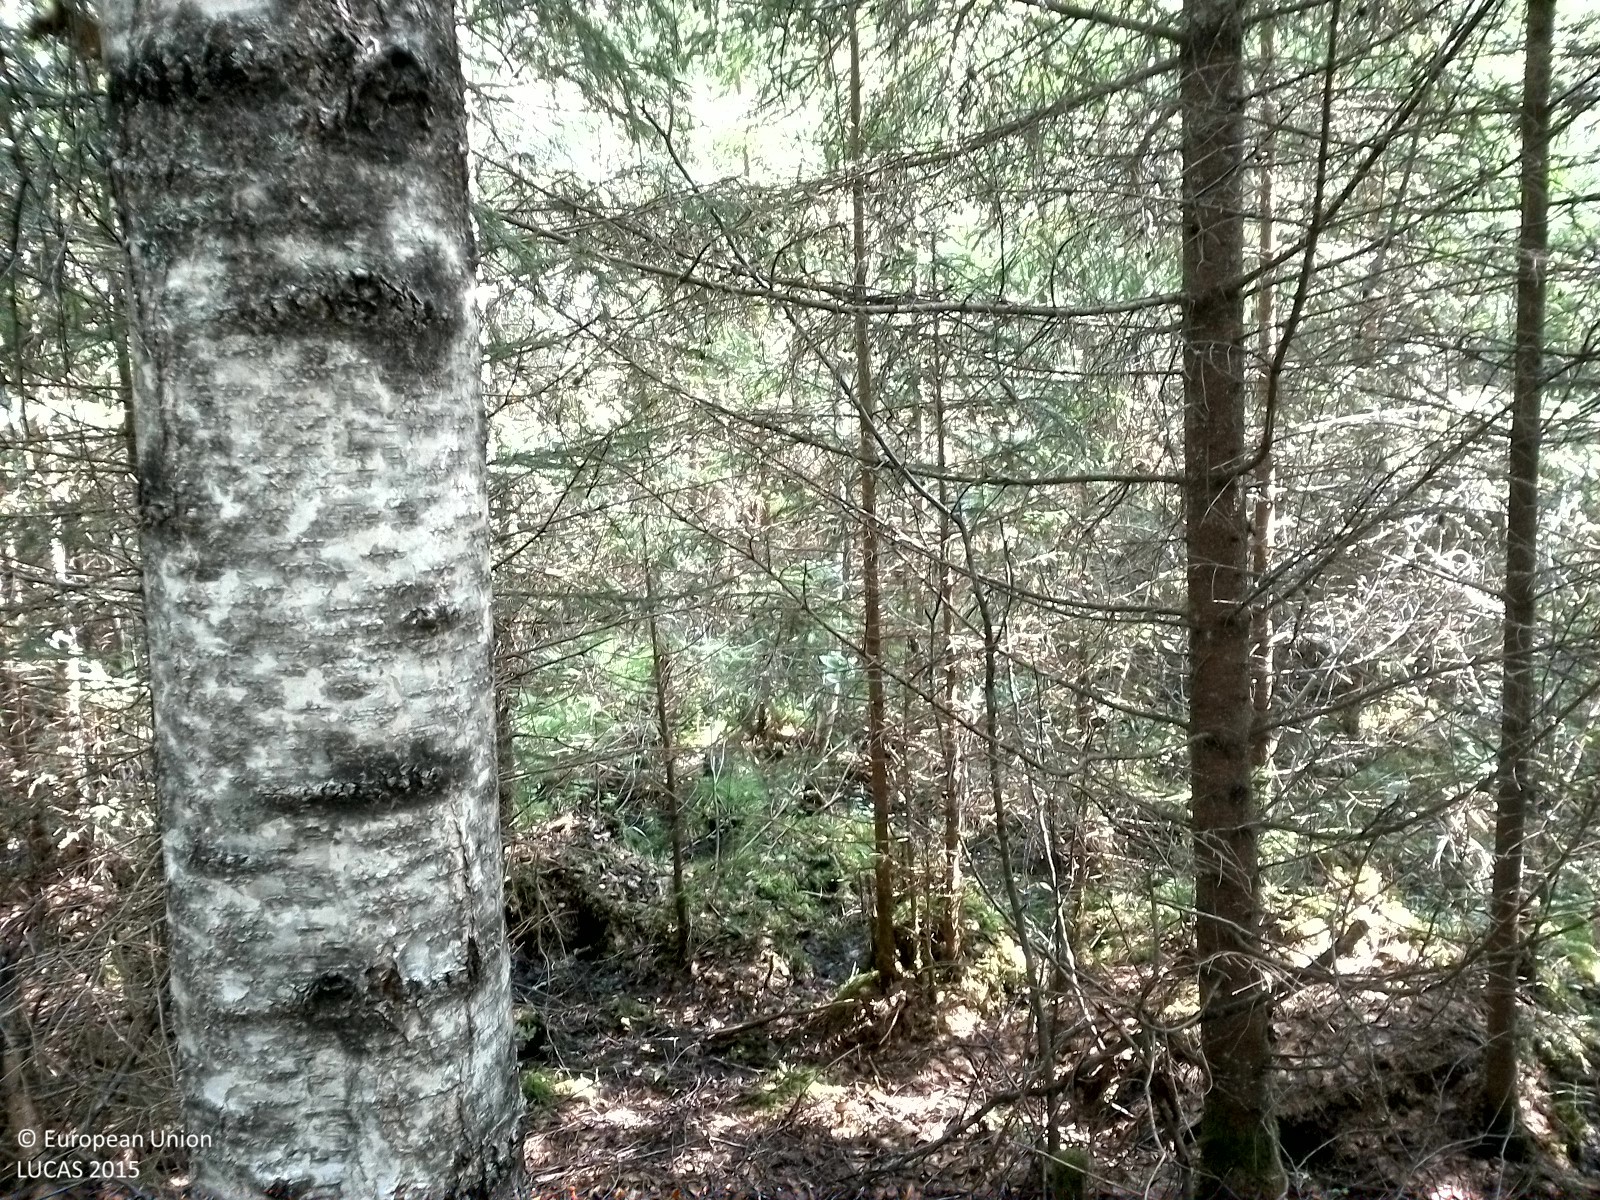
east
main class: Woodland
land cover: Spruce dominated mixed woodland
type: boreal forest
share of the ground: 50 - 75 %
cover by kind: coniferous forest trees 40 %, broadleaved forest trees 25 %, consolidated bare surface 20 %, lichens and mosses 10 %, herbaceous plants 5 %
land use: Forestry
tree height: < 5 m
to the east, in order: Spruce dominated mixed woodland; Spruce dominated coniferous woodland; Broadleaved woodland; Spontaneously vegetated surfaces
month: August
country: SE
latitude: 59.0856
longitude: 15.3846
